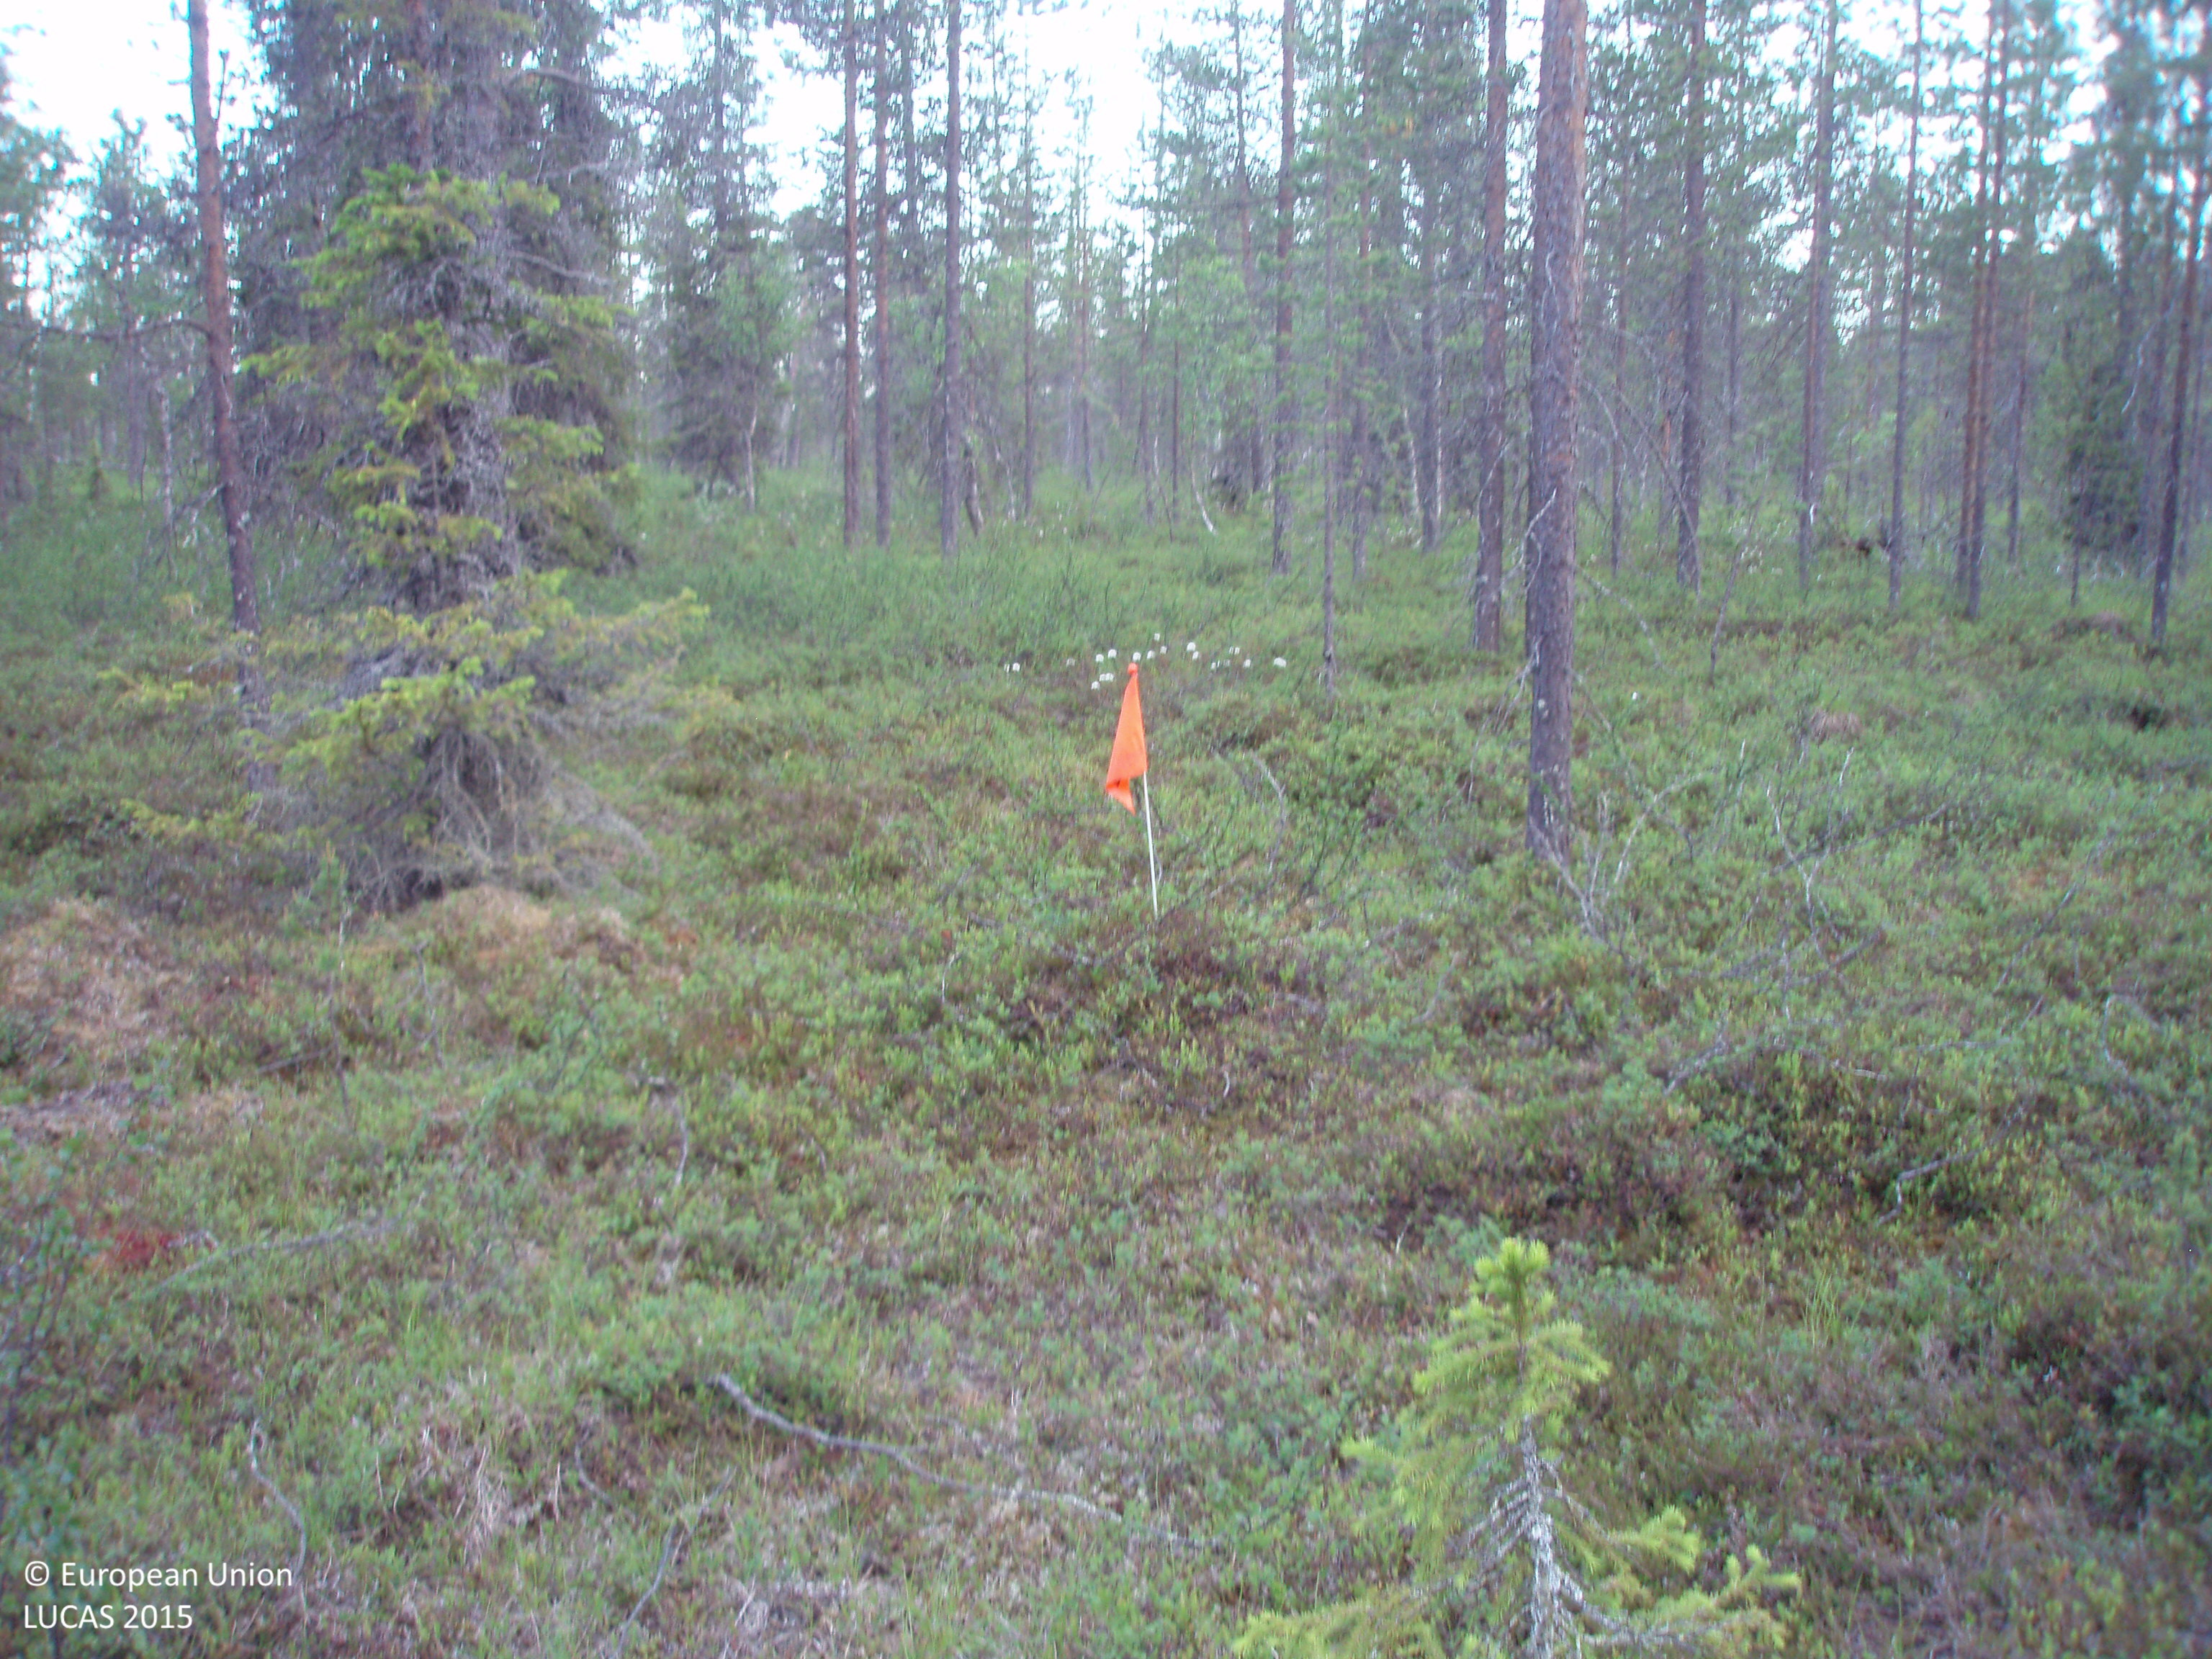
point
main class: Woodland
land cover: Pine dominated coniferous woodland
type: boreal forest
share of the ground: 50 - 75 %
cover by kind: coniferous forest trees 45 %, shrubs 45 %, broadleaved forest trees 5 %, lichens and mosses 5 %
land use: Forestry
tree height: > 5 m
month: July
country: FI
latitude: 67.7105
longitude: 29.2156
